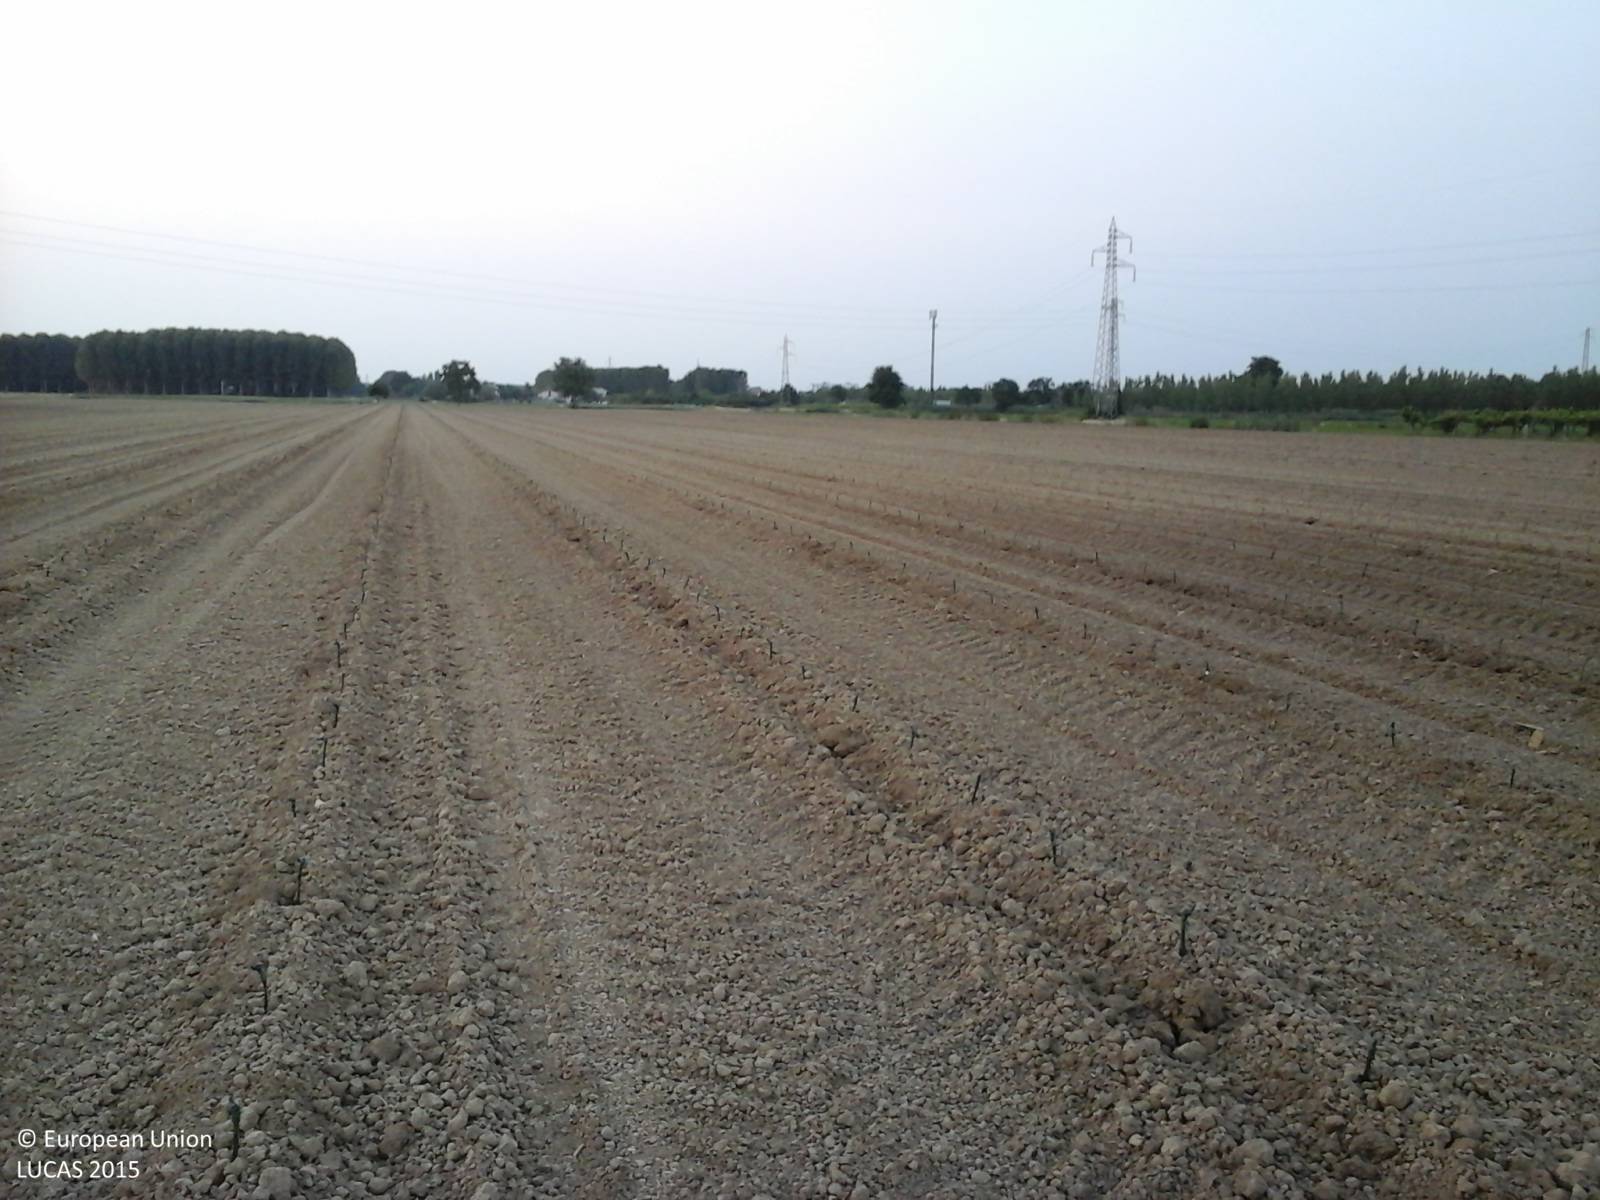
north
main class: Cropland
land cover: Vineyards
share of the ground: < 10 %
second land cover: Other bare soil
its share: > 75 %
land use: Agriculture (excluding fallow land and kitchen gardens)
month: June
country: IT
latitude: 45.8166
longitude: 13.2007
